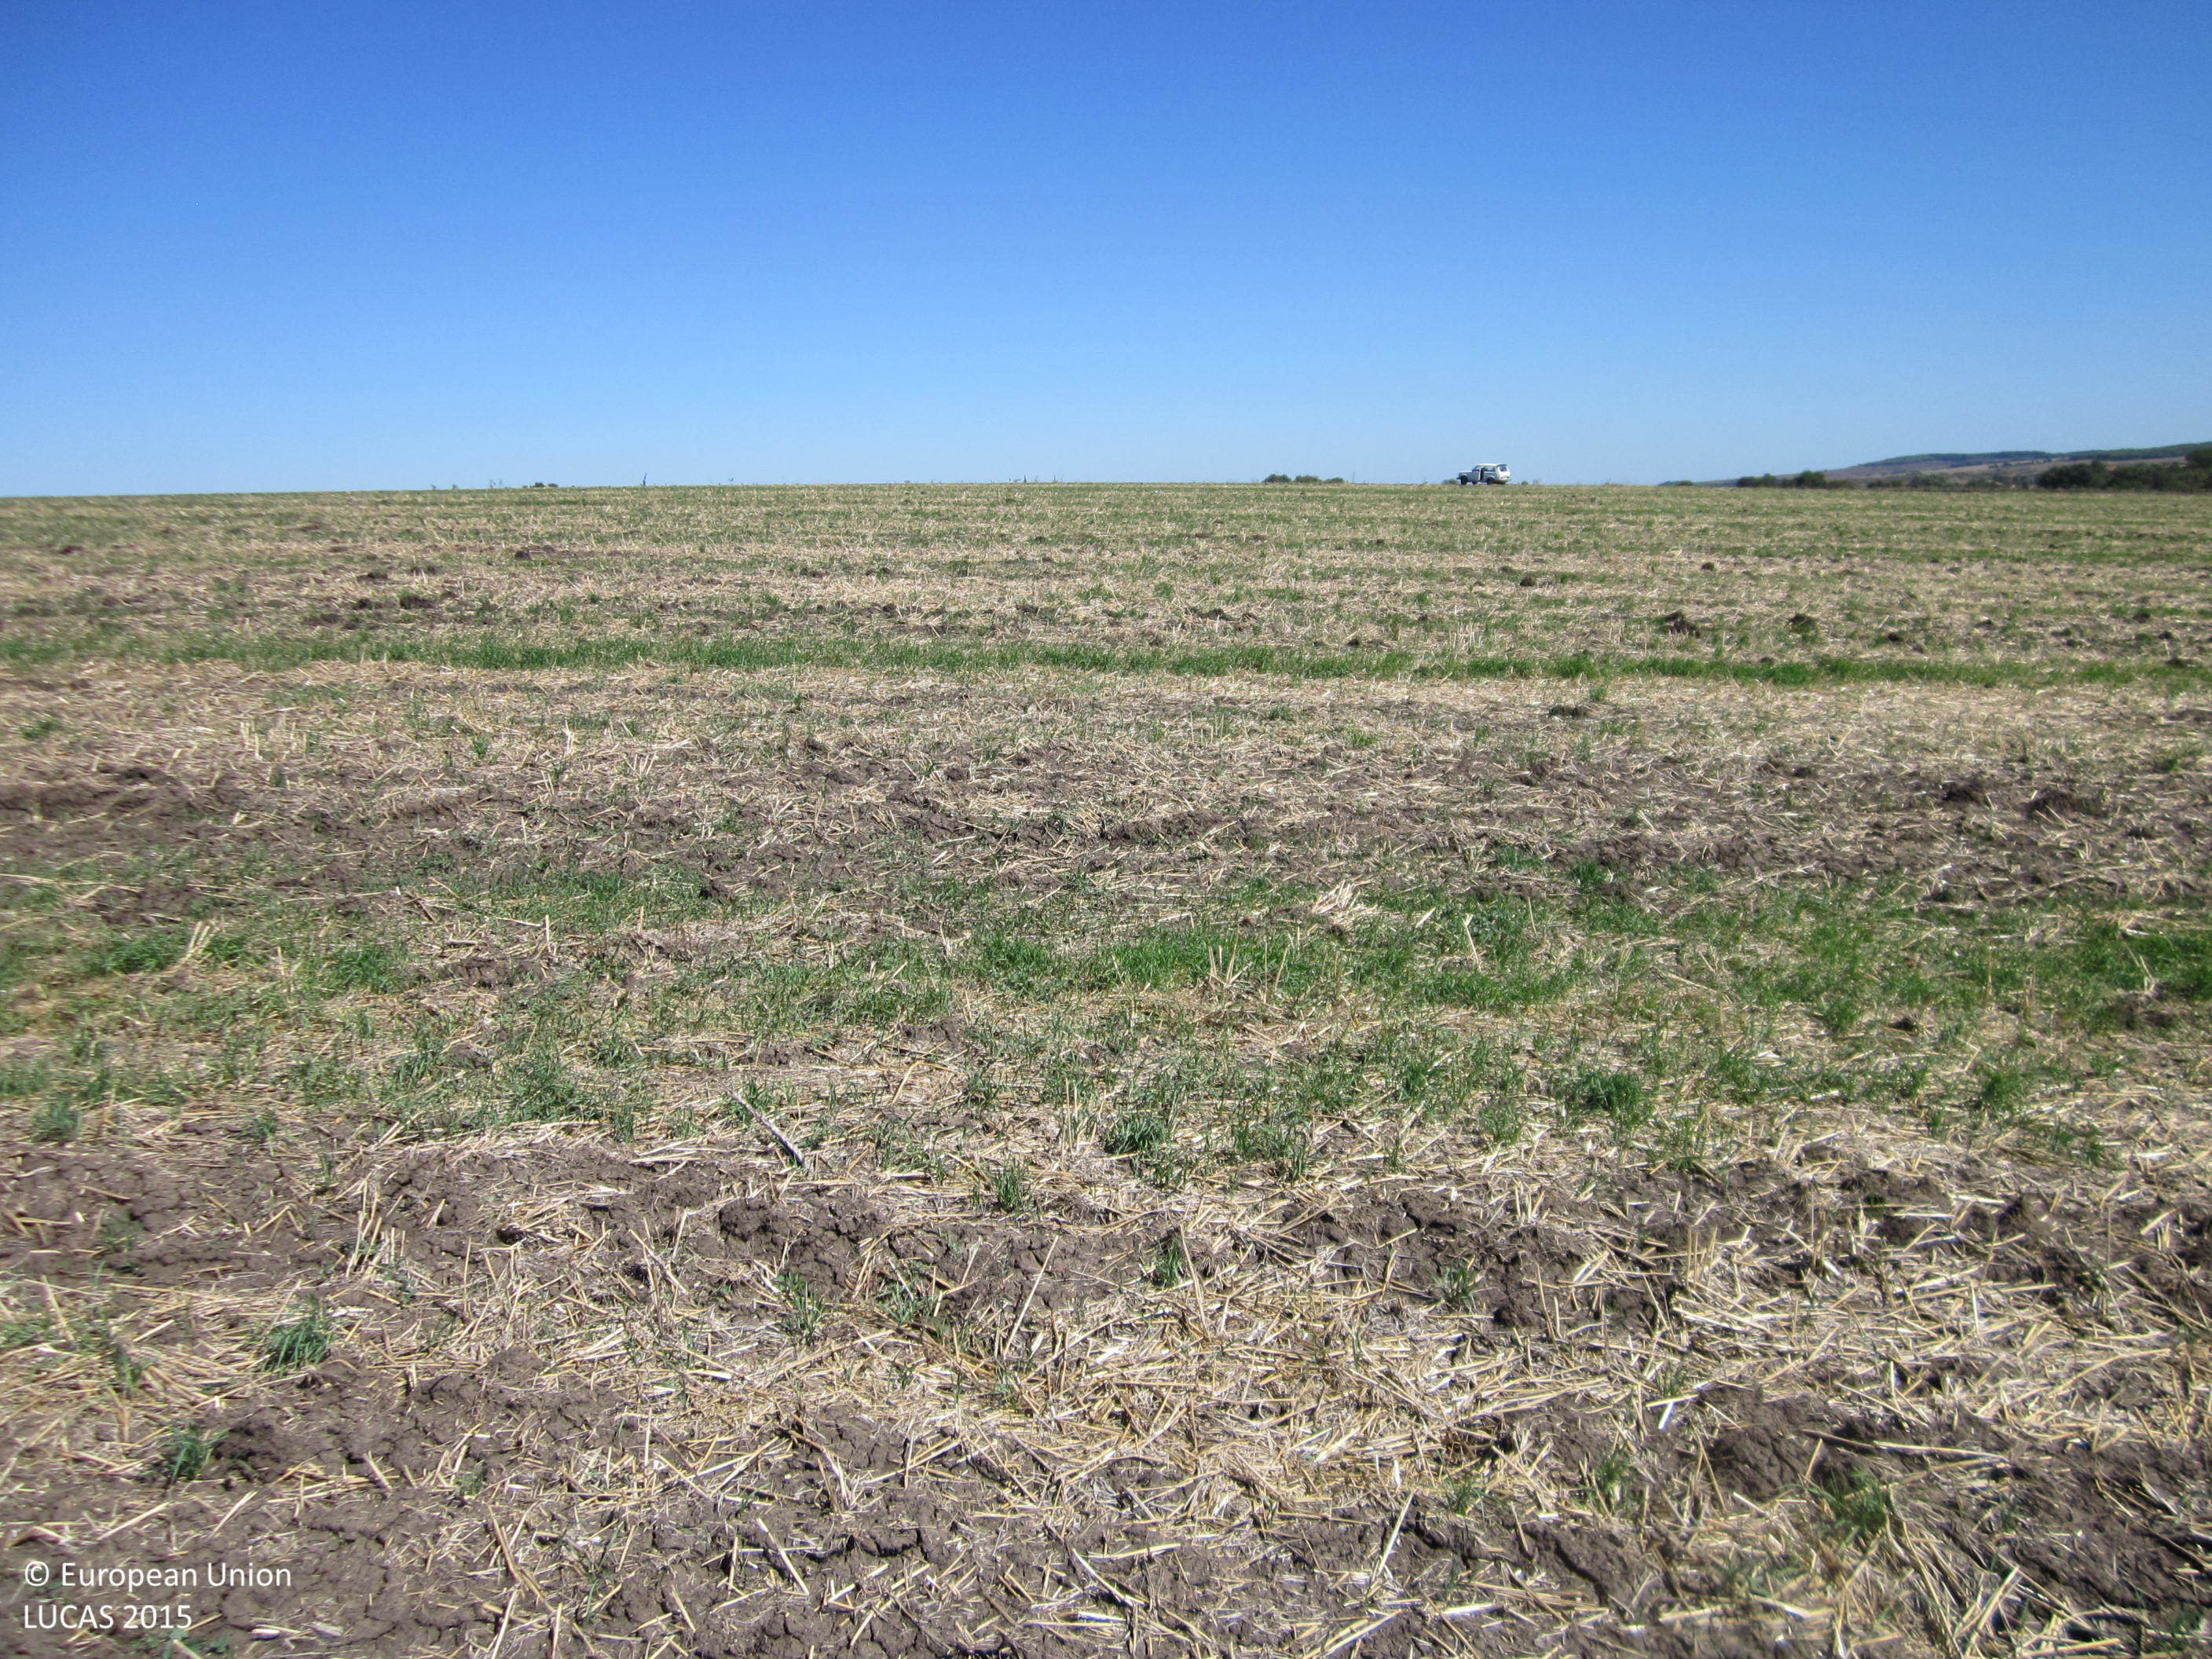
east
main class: Cropland
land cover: Common wheat
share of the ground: 25 - 50 %
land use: Agriculture (excluding fallow land and kitchen gardens)
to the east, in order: Common wheat; Grass margins; Tracks; Grass margins; Other bare soil
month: September
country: BG
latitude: 42.4886
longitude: 27.0285
